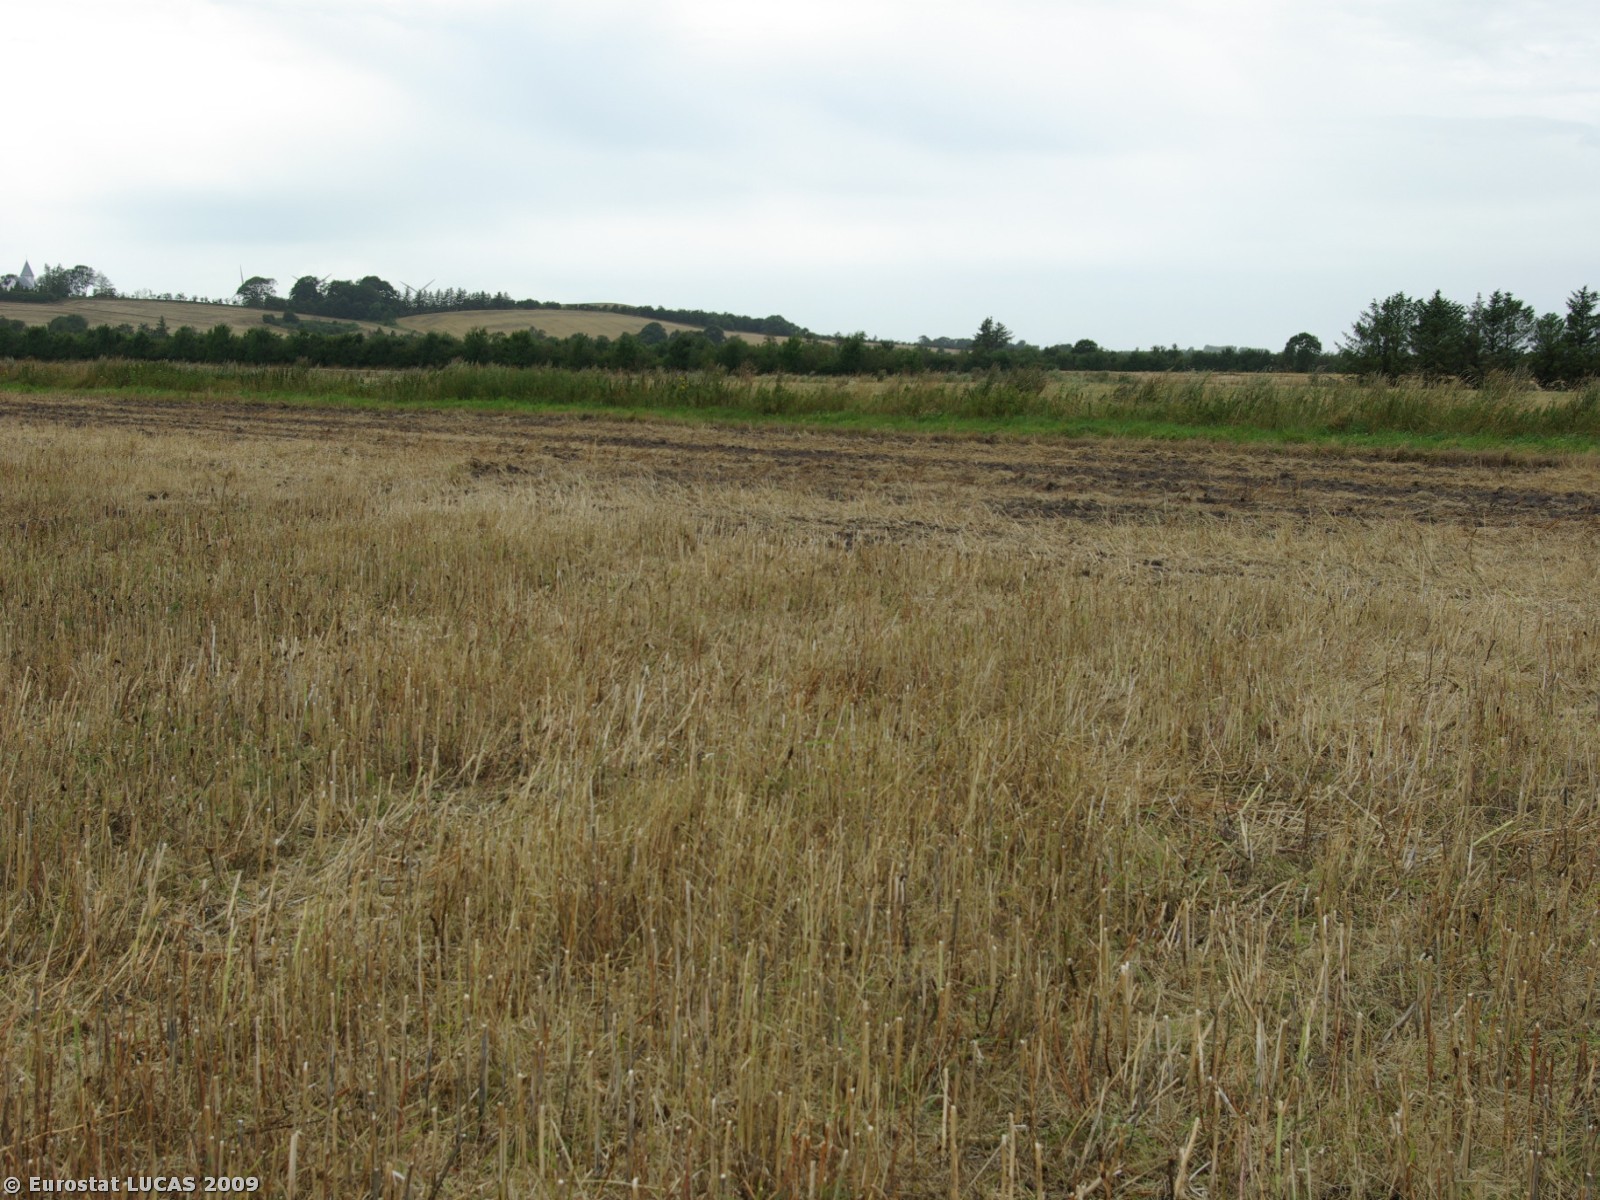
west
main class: Cropland
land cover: Rape and turnip rape
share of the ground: < 10 %
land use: Agriculture (excluding fallow land and kitchen gardens)
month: July
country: DK
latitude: 55.2312
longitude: 9.0103
